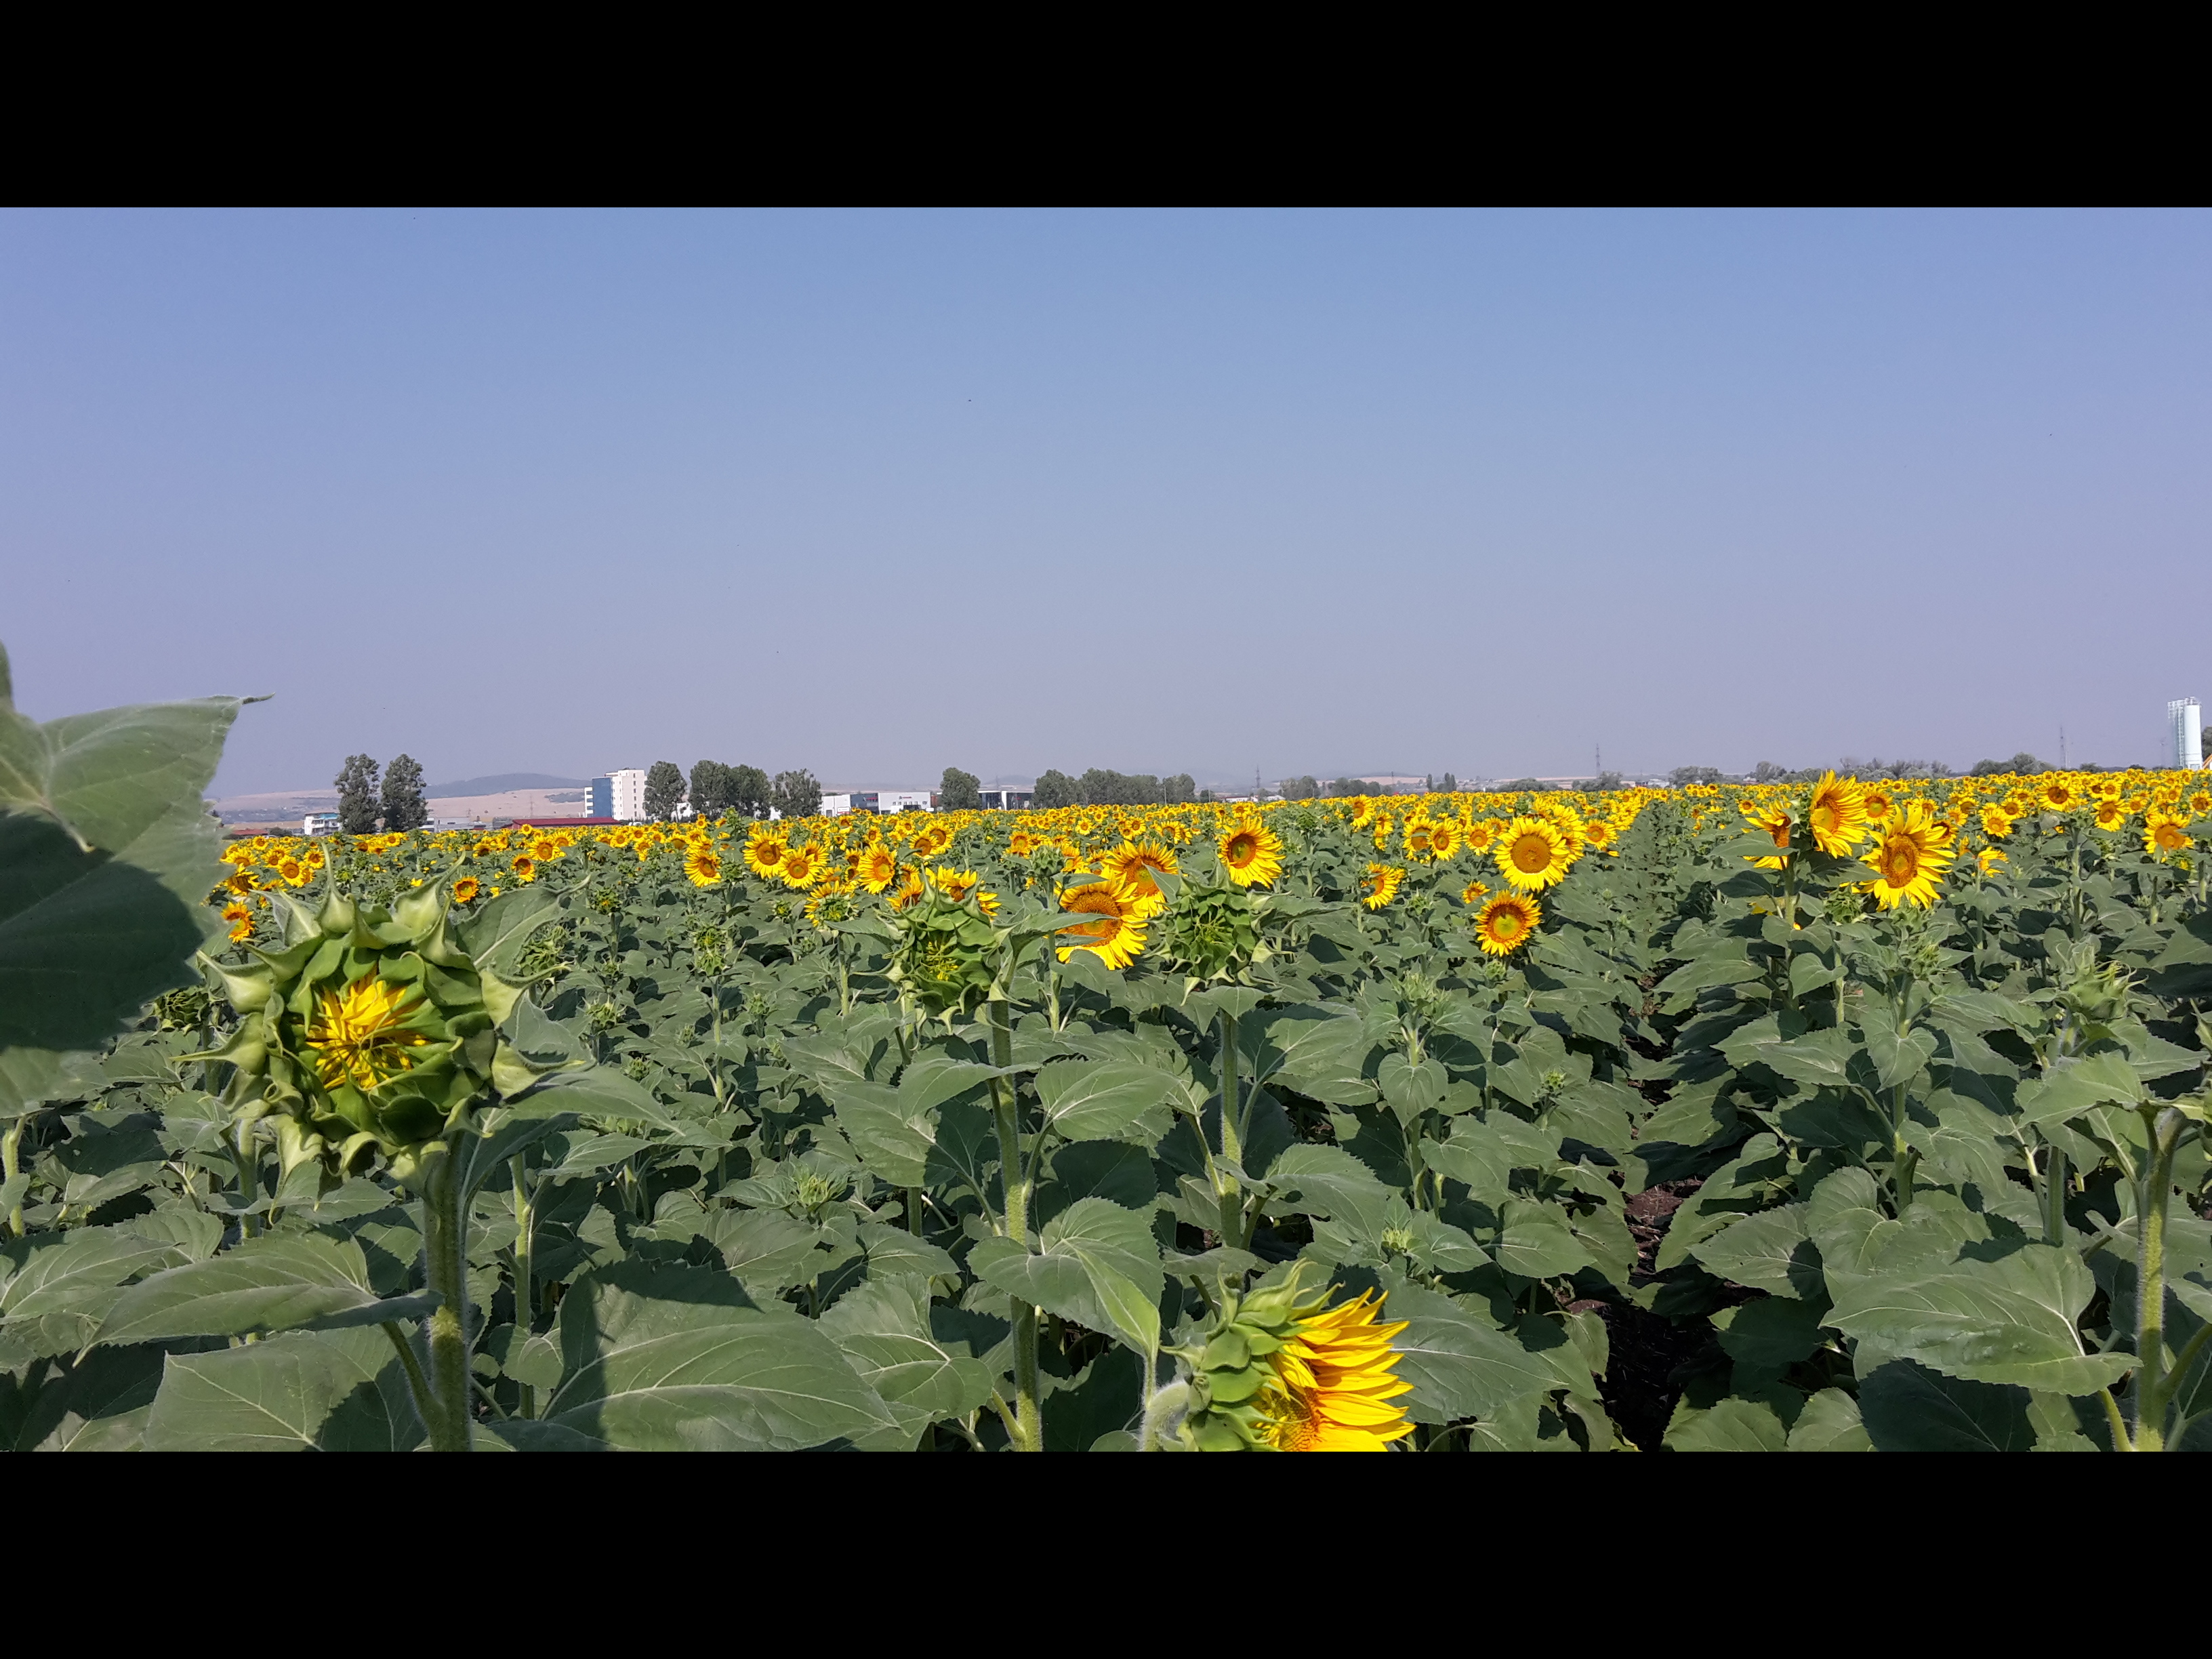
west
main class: Cropland
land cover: Sunflower
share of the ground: > 75 %
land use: Agriculture (excluding fallow land and kitchen gardens)
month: July
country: BG
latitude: 42.7731
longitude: 23.1962
